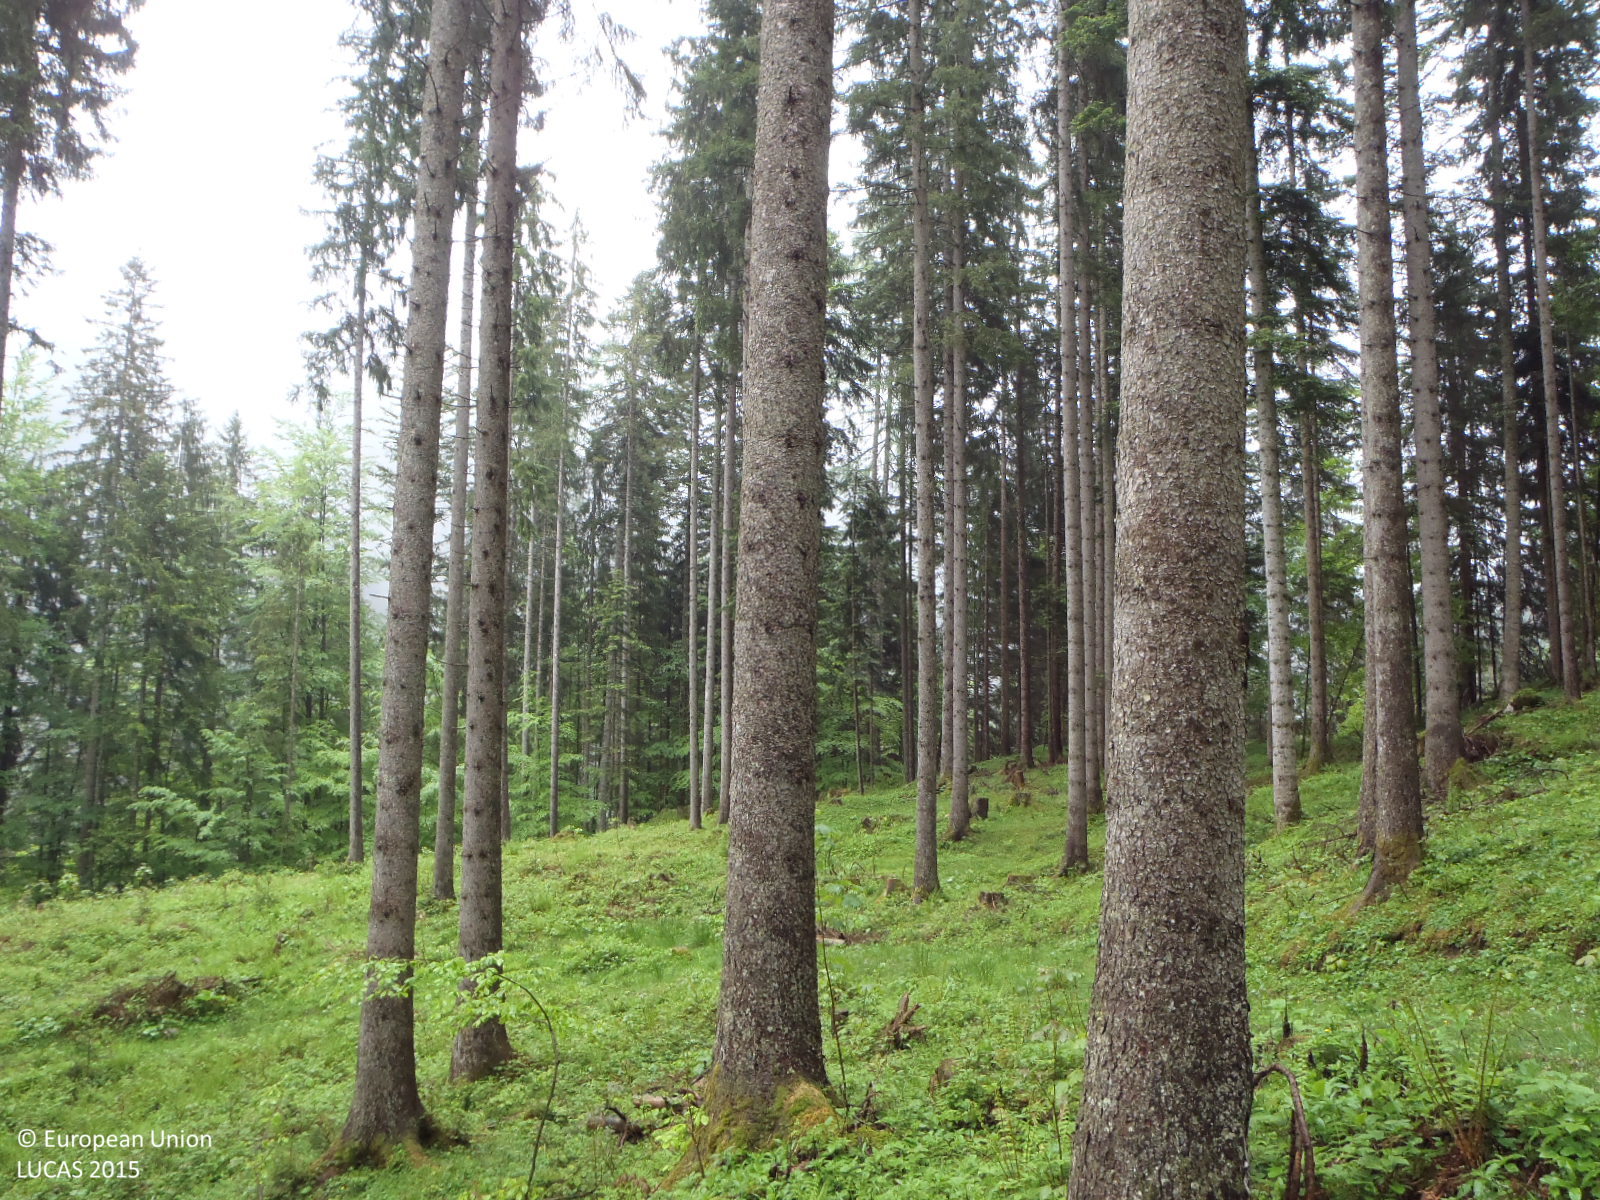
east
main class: Woodland
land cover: Other coniferous woodland
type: alpine coniferous forest
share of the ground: 50 - 75 %
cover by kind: coniferous forest trees 60 %, herbaceous plants 20 %, shrubs 10 %, lichens and mosses 10 %
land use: Forestry
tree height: > 5 m
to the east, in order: Other coniferous woodland; Tracks; Other coniferous woodland; Other mixed woodland; Tracks; Other mixed woodland; Inland fresh running water; Other mixed woodland; Rivers and streams; Other mixed woodland; Tracks
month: May
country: AT
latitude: 47.5950
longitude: 12.7513
